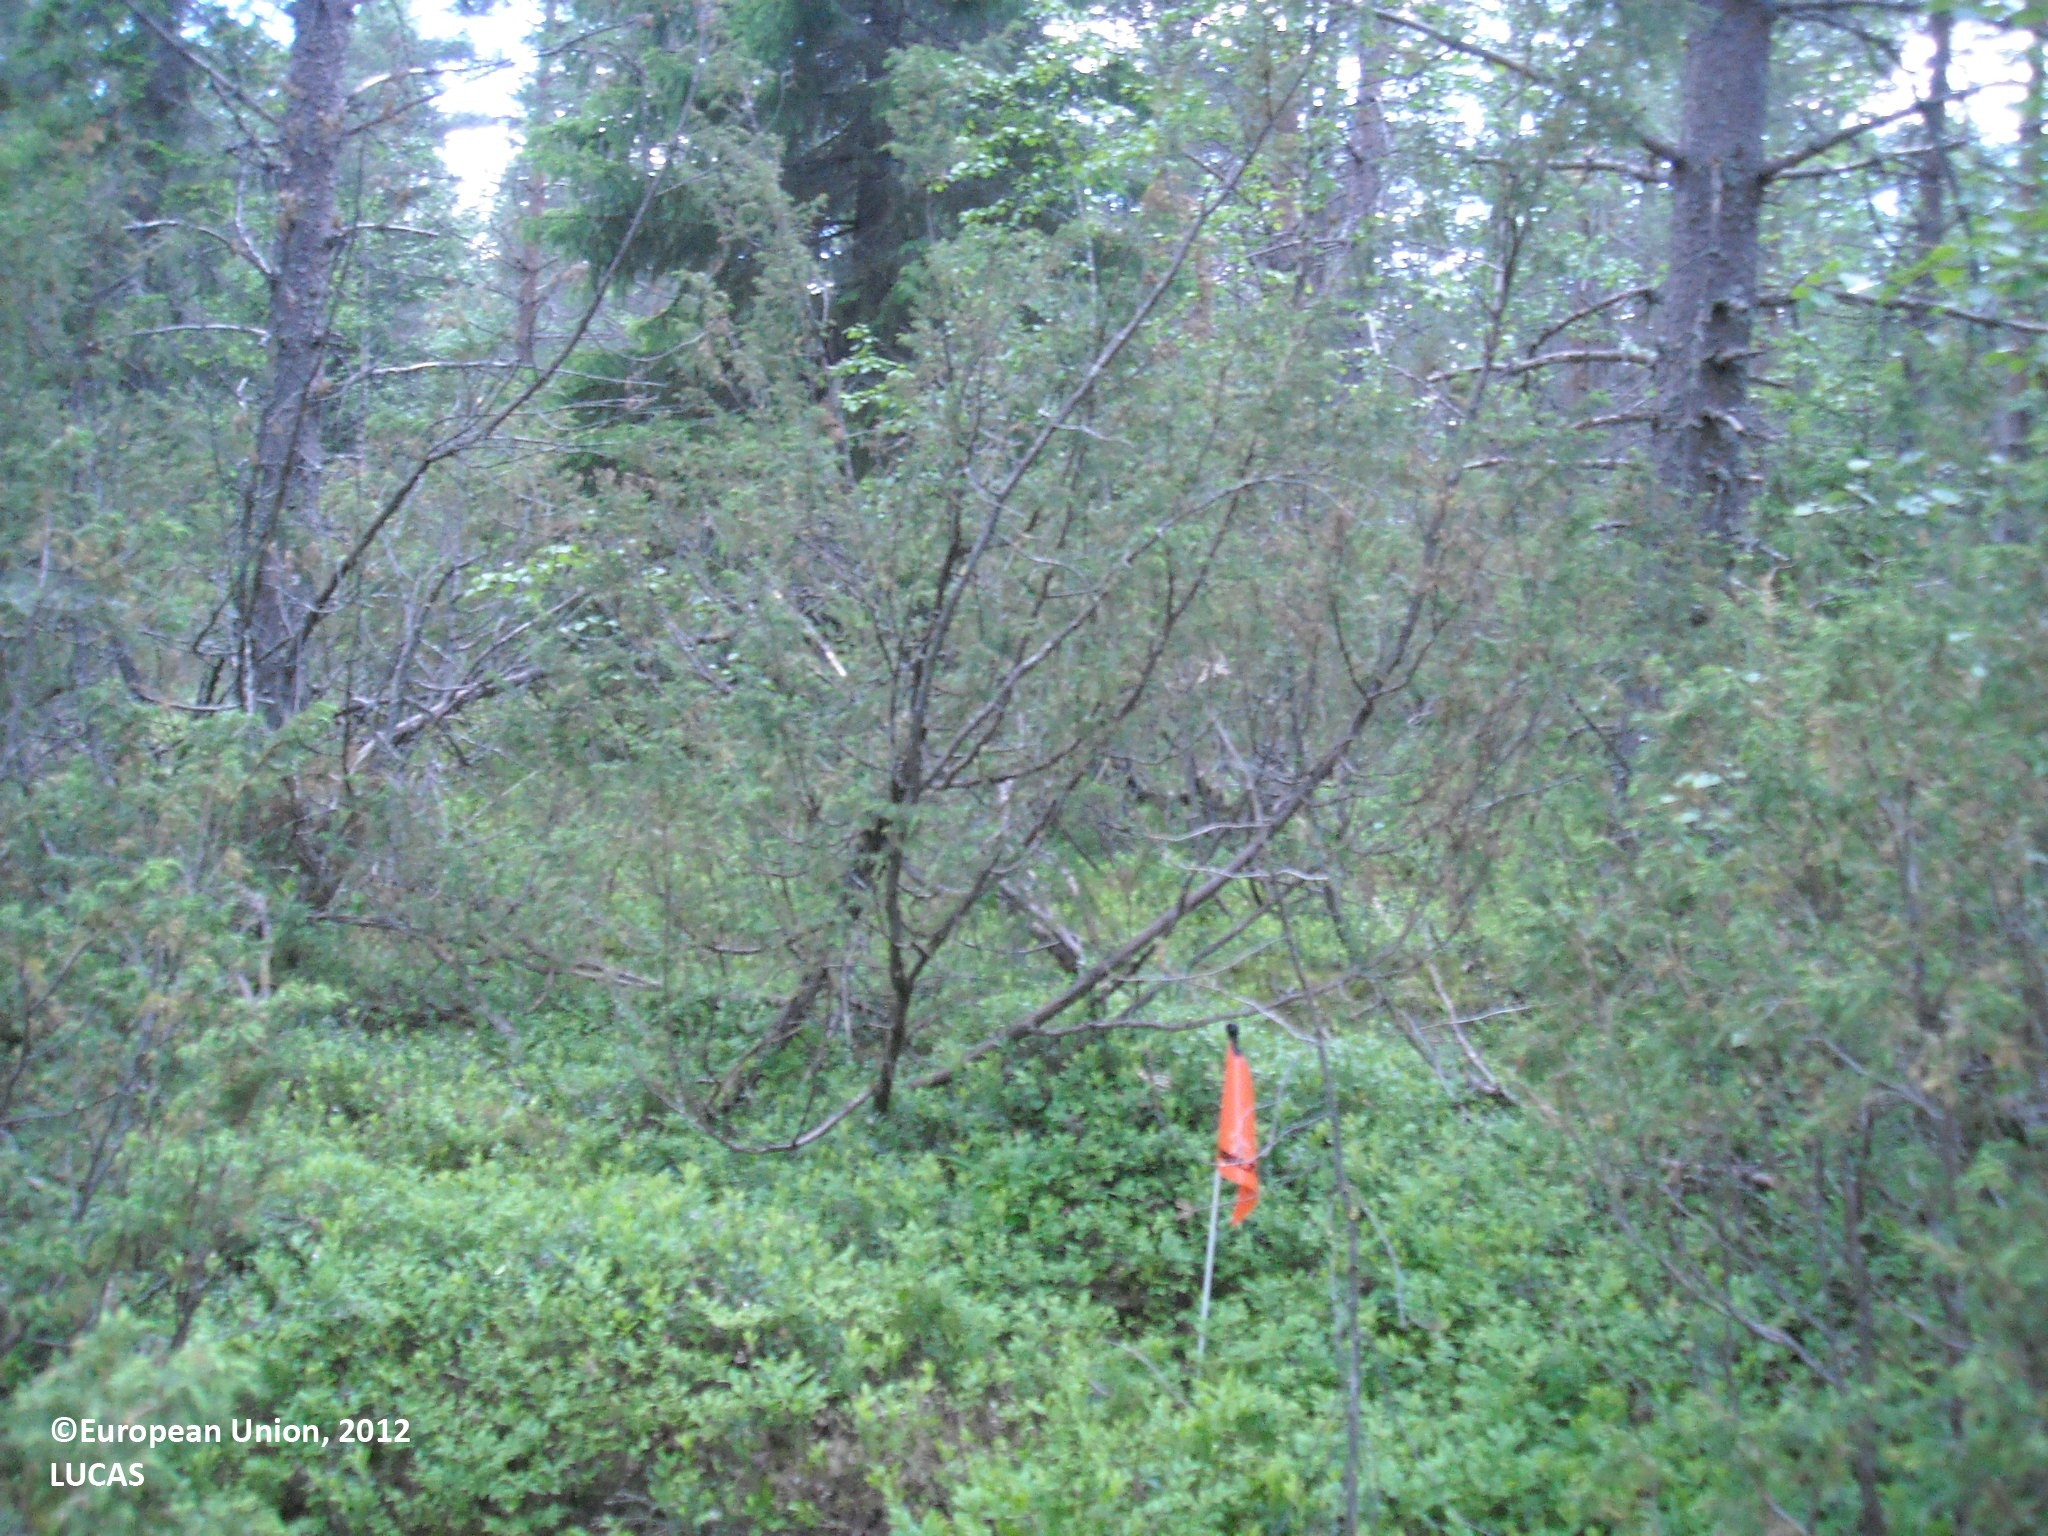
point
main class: Woodland
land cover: Other coniferous woodland
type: boreal forest
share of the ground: > 75 %
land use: Forestry
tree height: > 5 m
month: July
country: FI
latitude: 64.6112
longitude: 27.7718
